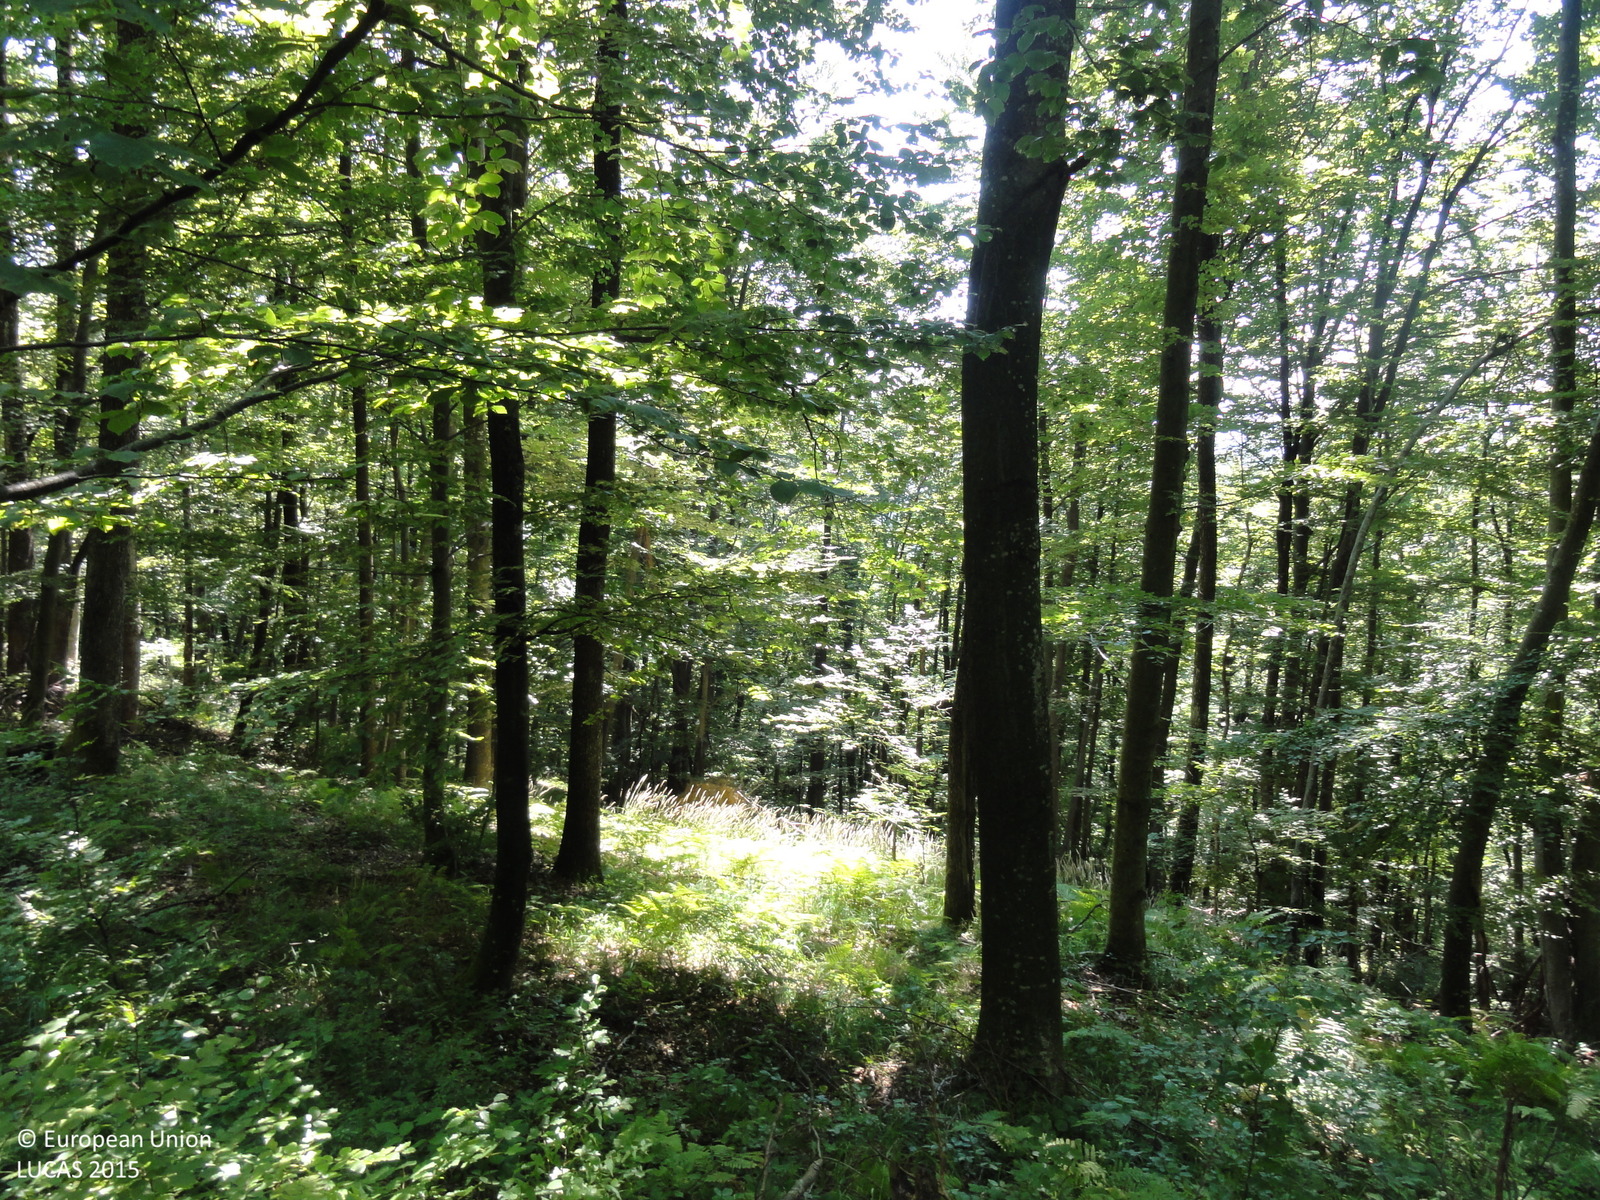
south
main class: Woodland
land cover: Broadleaved woodland
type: beech forest
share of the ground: > 75 %
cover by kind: broadleaved forest trees 100 %
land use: Forestry
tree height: > 5 m
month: August
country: SI
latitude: 45.9988
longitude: 15.0197
